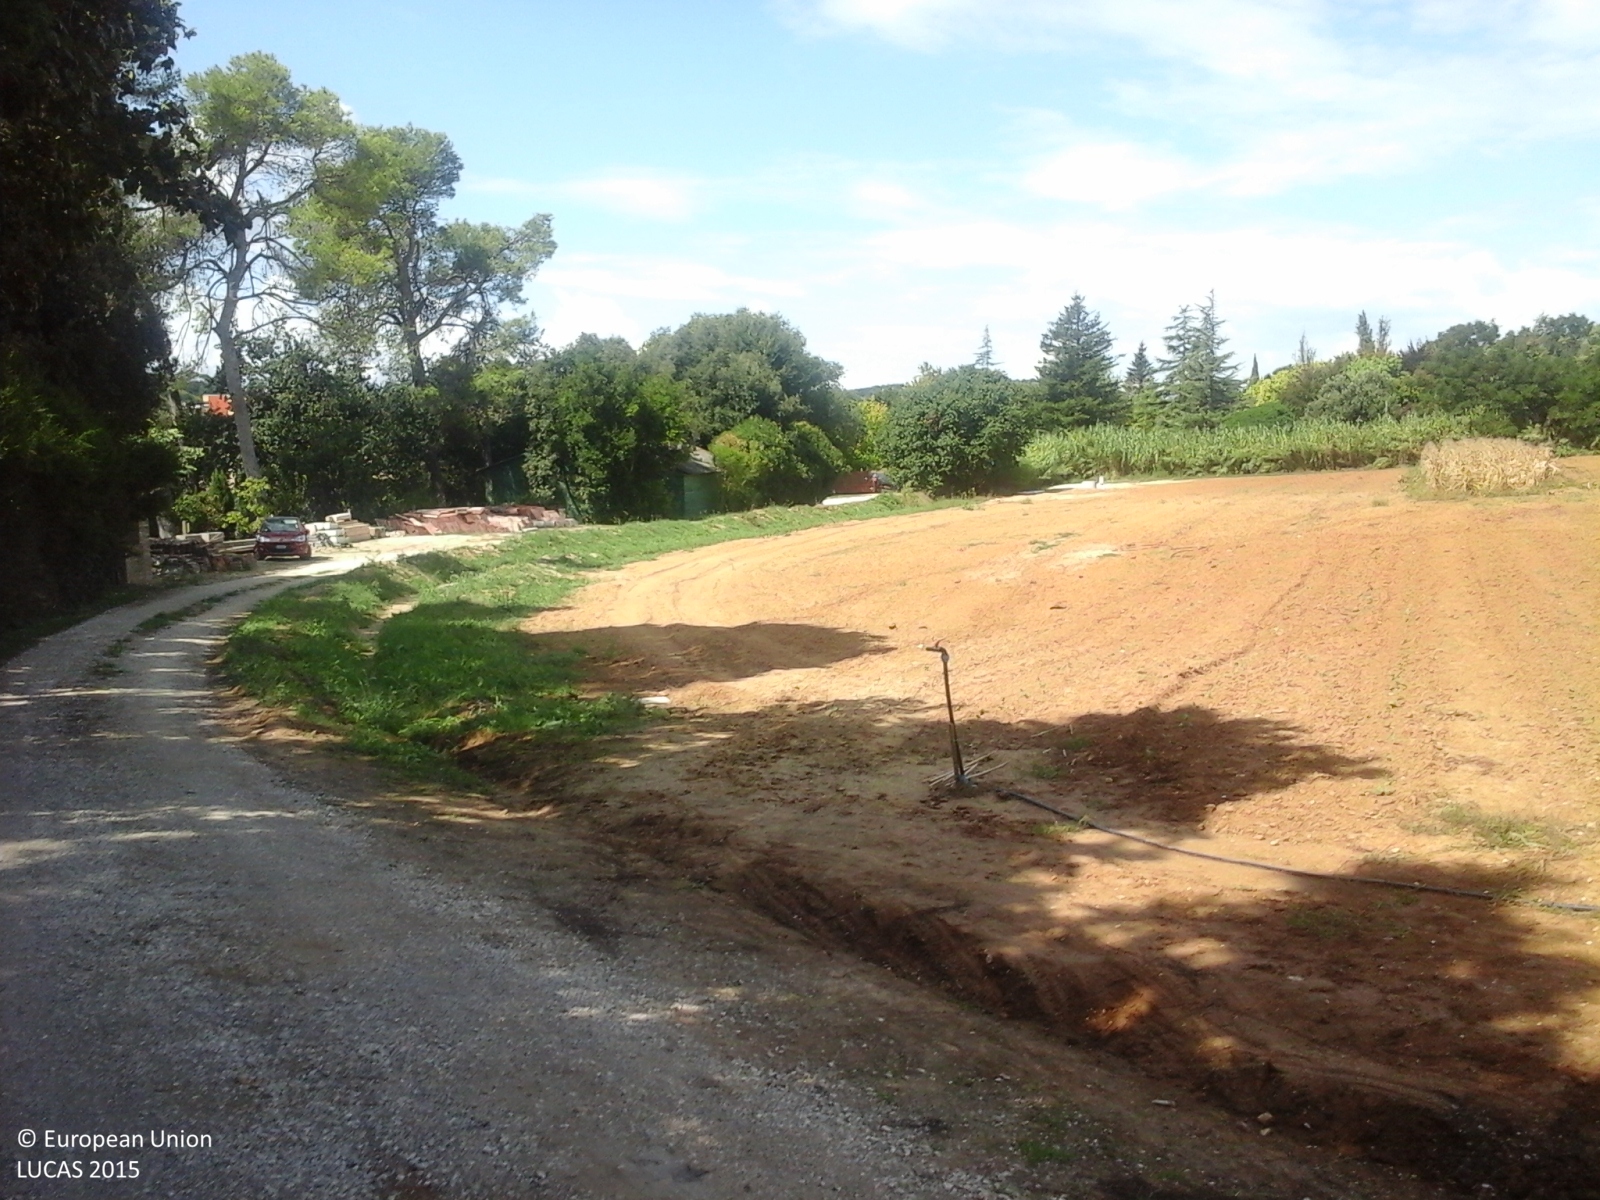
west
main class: Woodland
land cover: Broadleaved woodland
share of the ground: > 75 %
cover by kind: broadleaved forest trees 100 %
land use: Residential
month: September
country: IT
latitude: 43.9138
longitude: 12.8700
